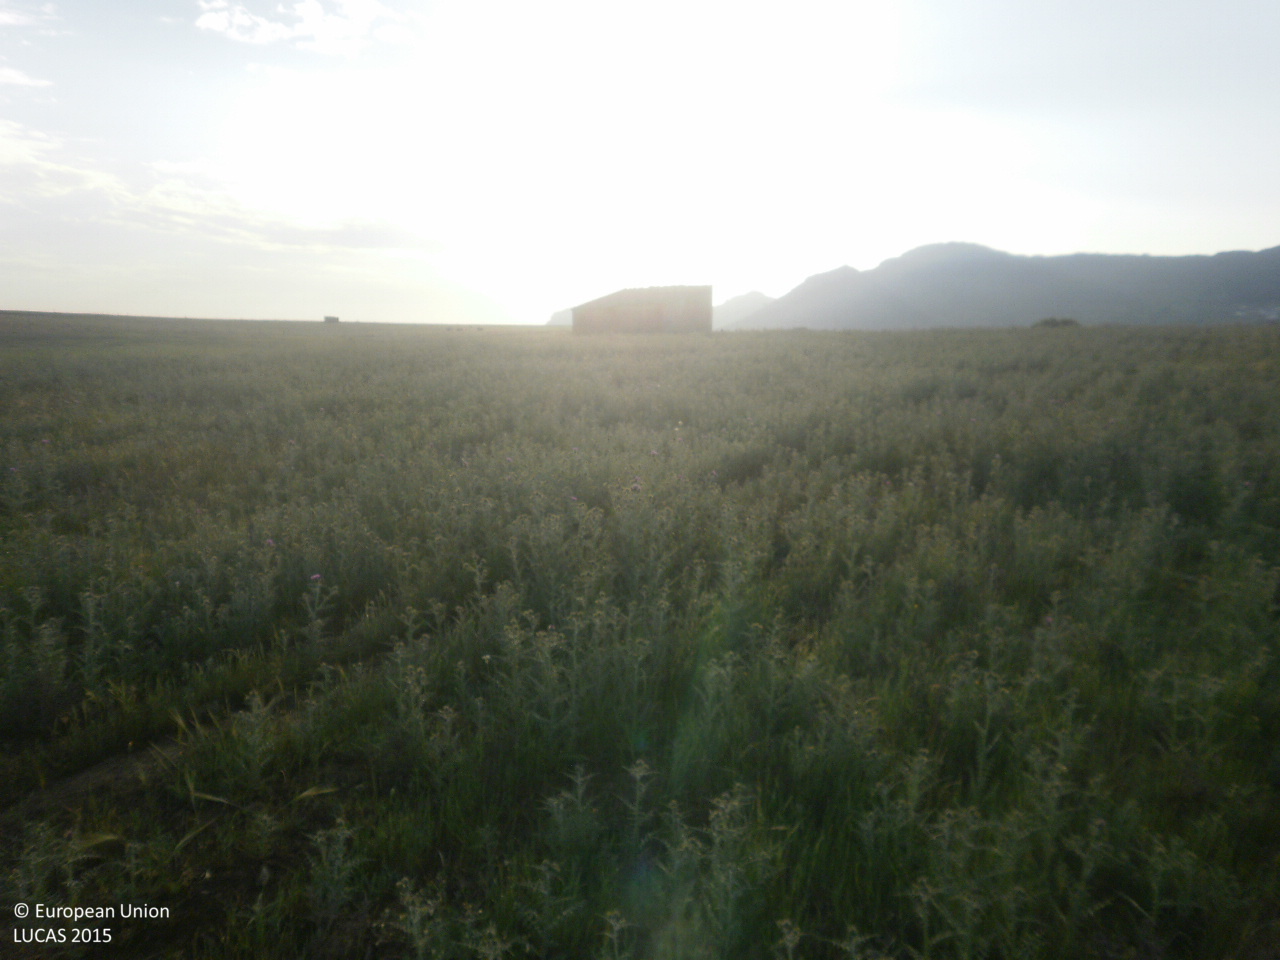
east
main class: Grassland
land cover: Grassland without tree/shrub cover
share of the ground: > 75 %
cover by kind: herbaceous plants 100 %
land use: Agriculture (excluding fallow land and kitchen gardens)
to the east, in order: Grassland without tree/shrub cover; Artificial constructions in urban areas; Grassland without tree/shrub cover; Rivers and streams; Grassland without tree/shrub cover
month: April
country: ES
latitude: 38.8209
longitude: -5.1814
